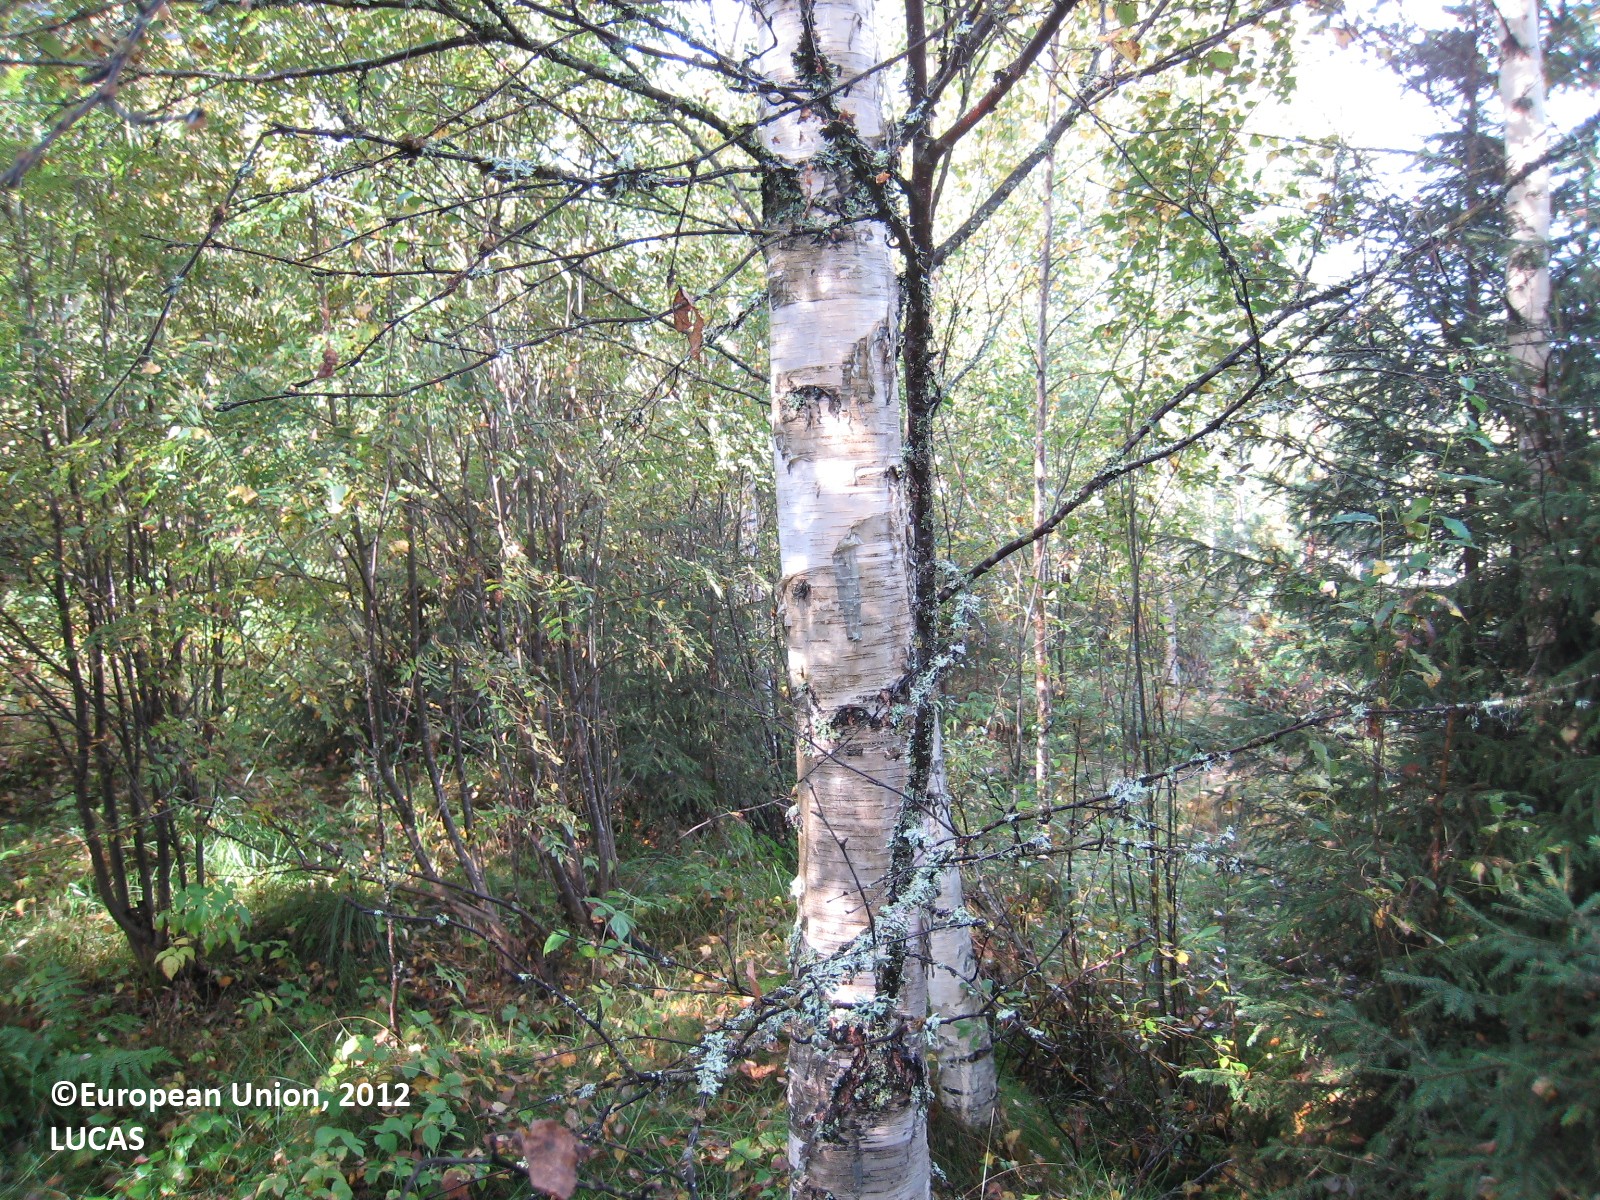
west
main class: Woodland
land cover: Spruce dominated mixed woodland
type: boreal forest
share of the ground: > 75 %
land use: Forestry
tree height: > 5 m
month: September
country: FI
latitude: 63.1110
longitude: 26.7257
